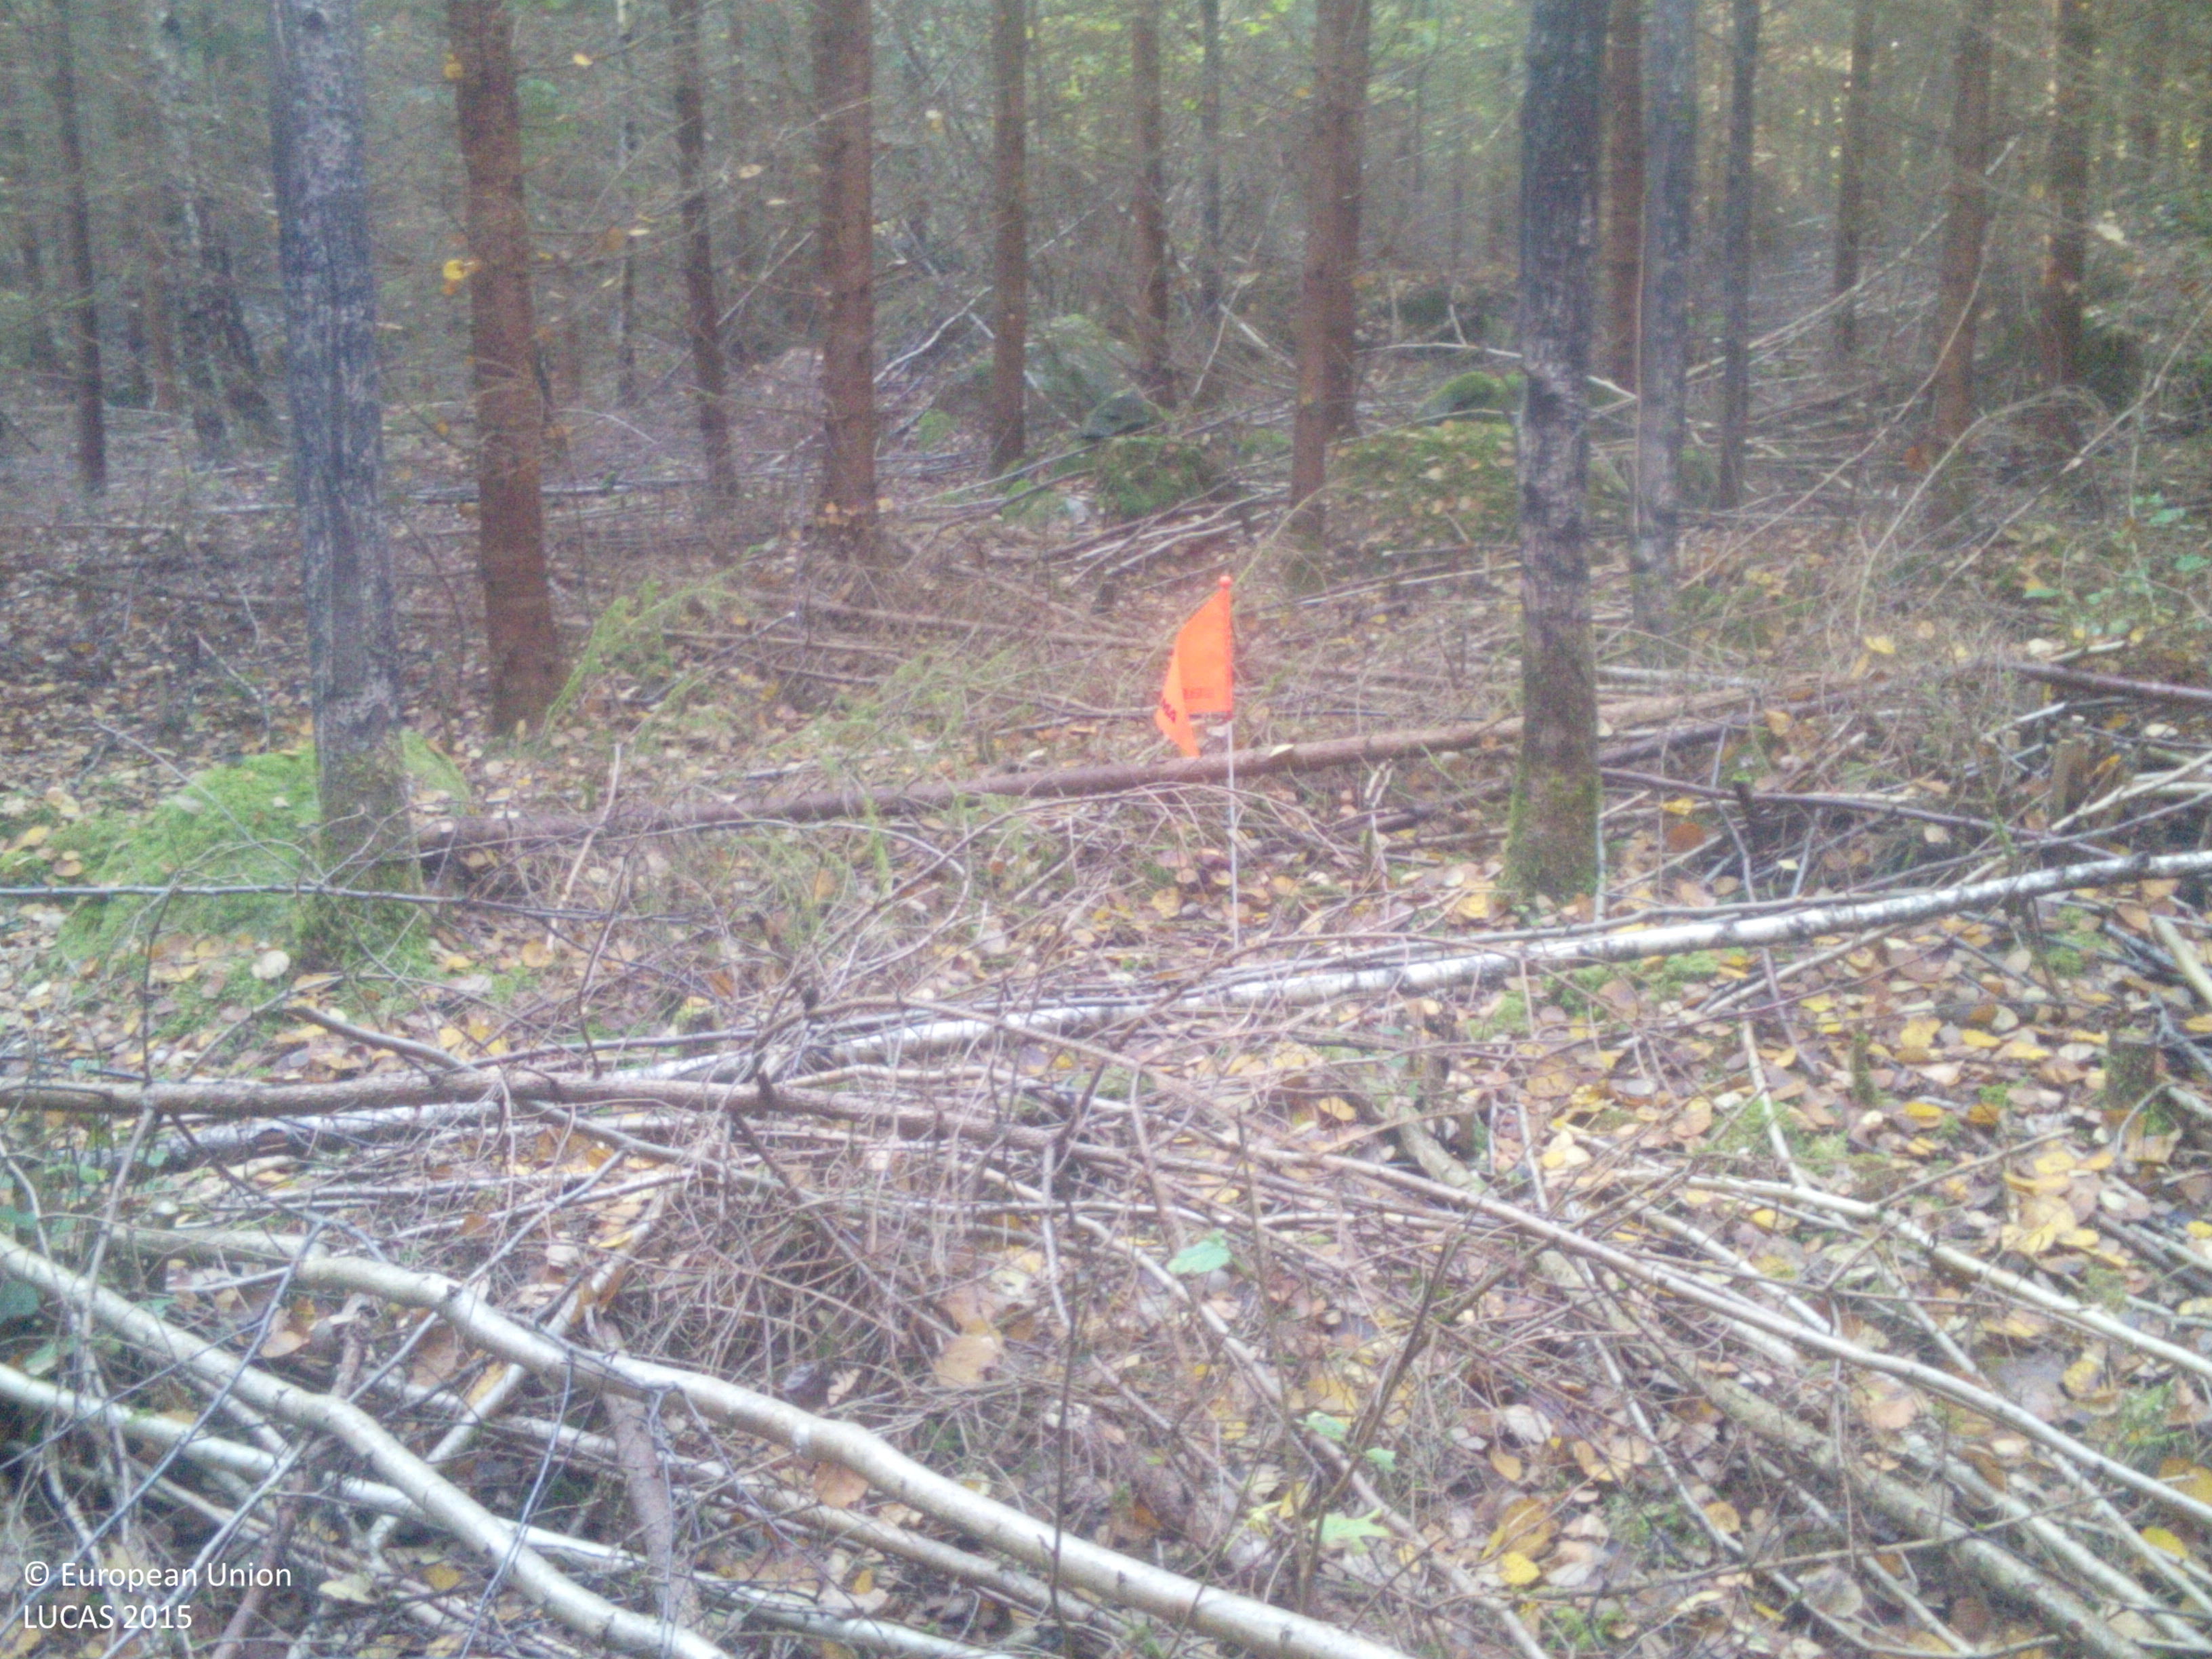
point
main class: Woodland
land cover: Spruce dominated mixed woodland
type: boreal forest
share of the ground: > 75 %
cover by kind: coniferous forest trees 55 %, broadleaved forest trees 40 %, lichens and mosses 5 %
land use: Forestry
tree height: > 5 m
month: October
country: SE
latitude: 58.8943
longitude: 16.4678
